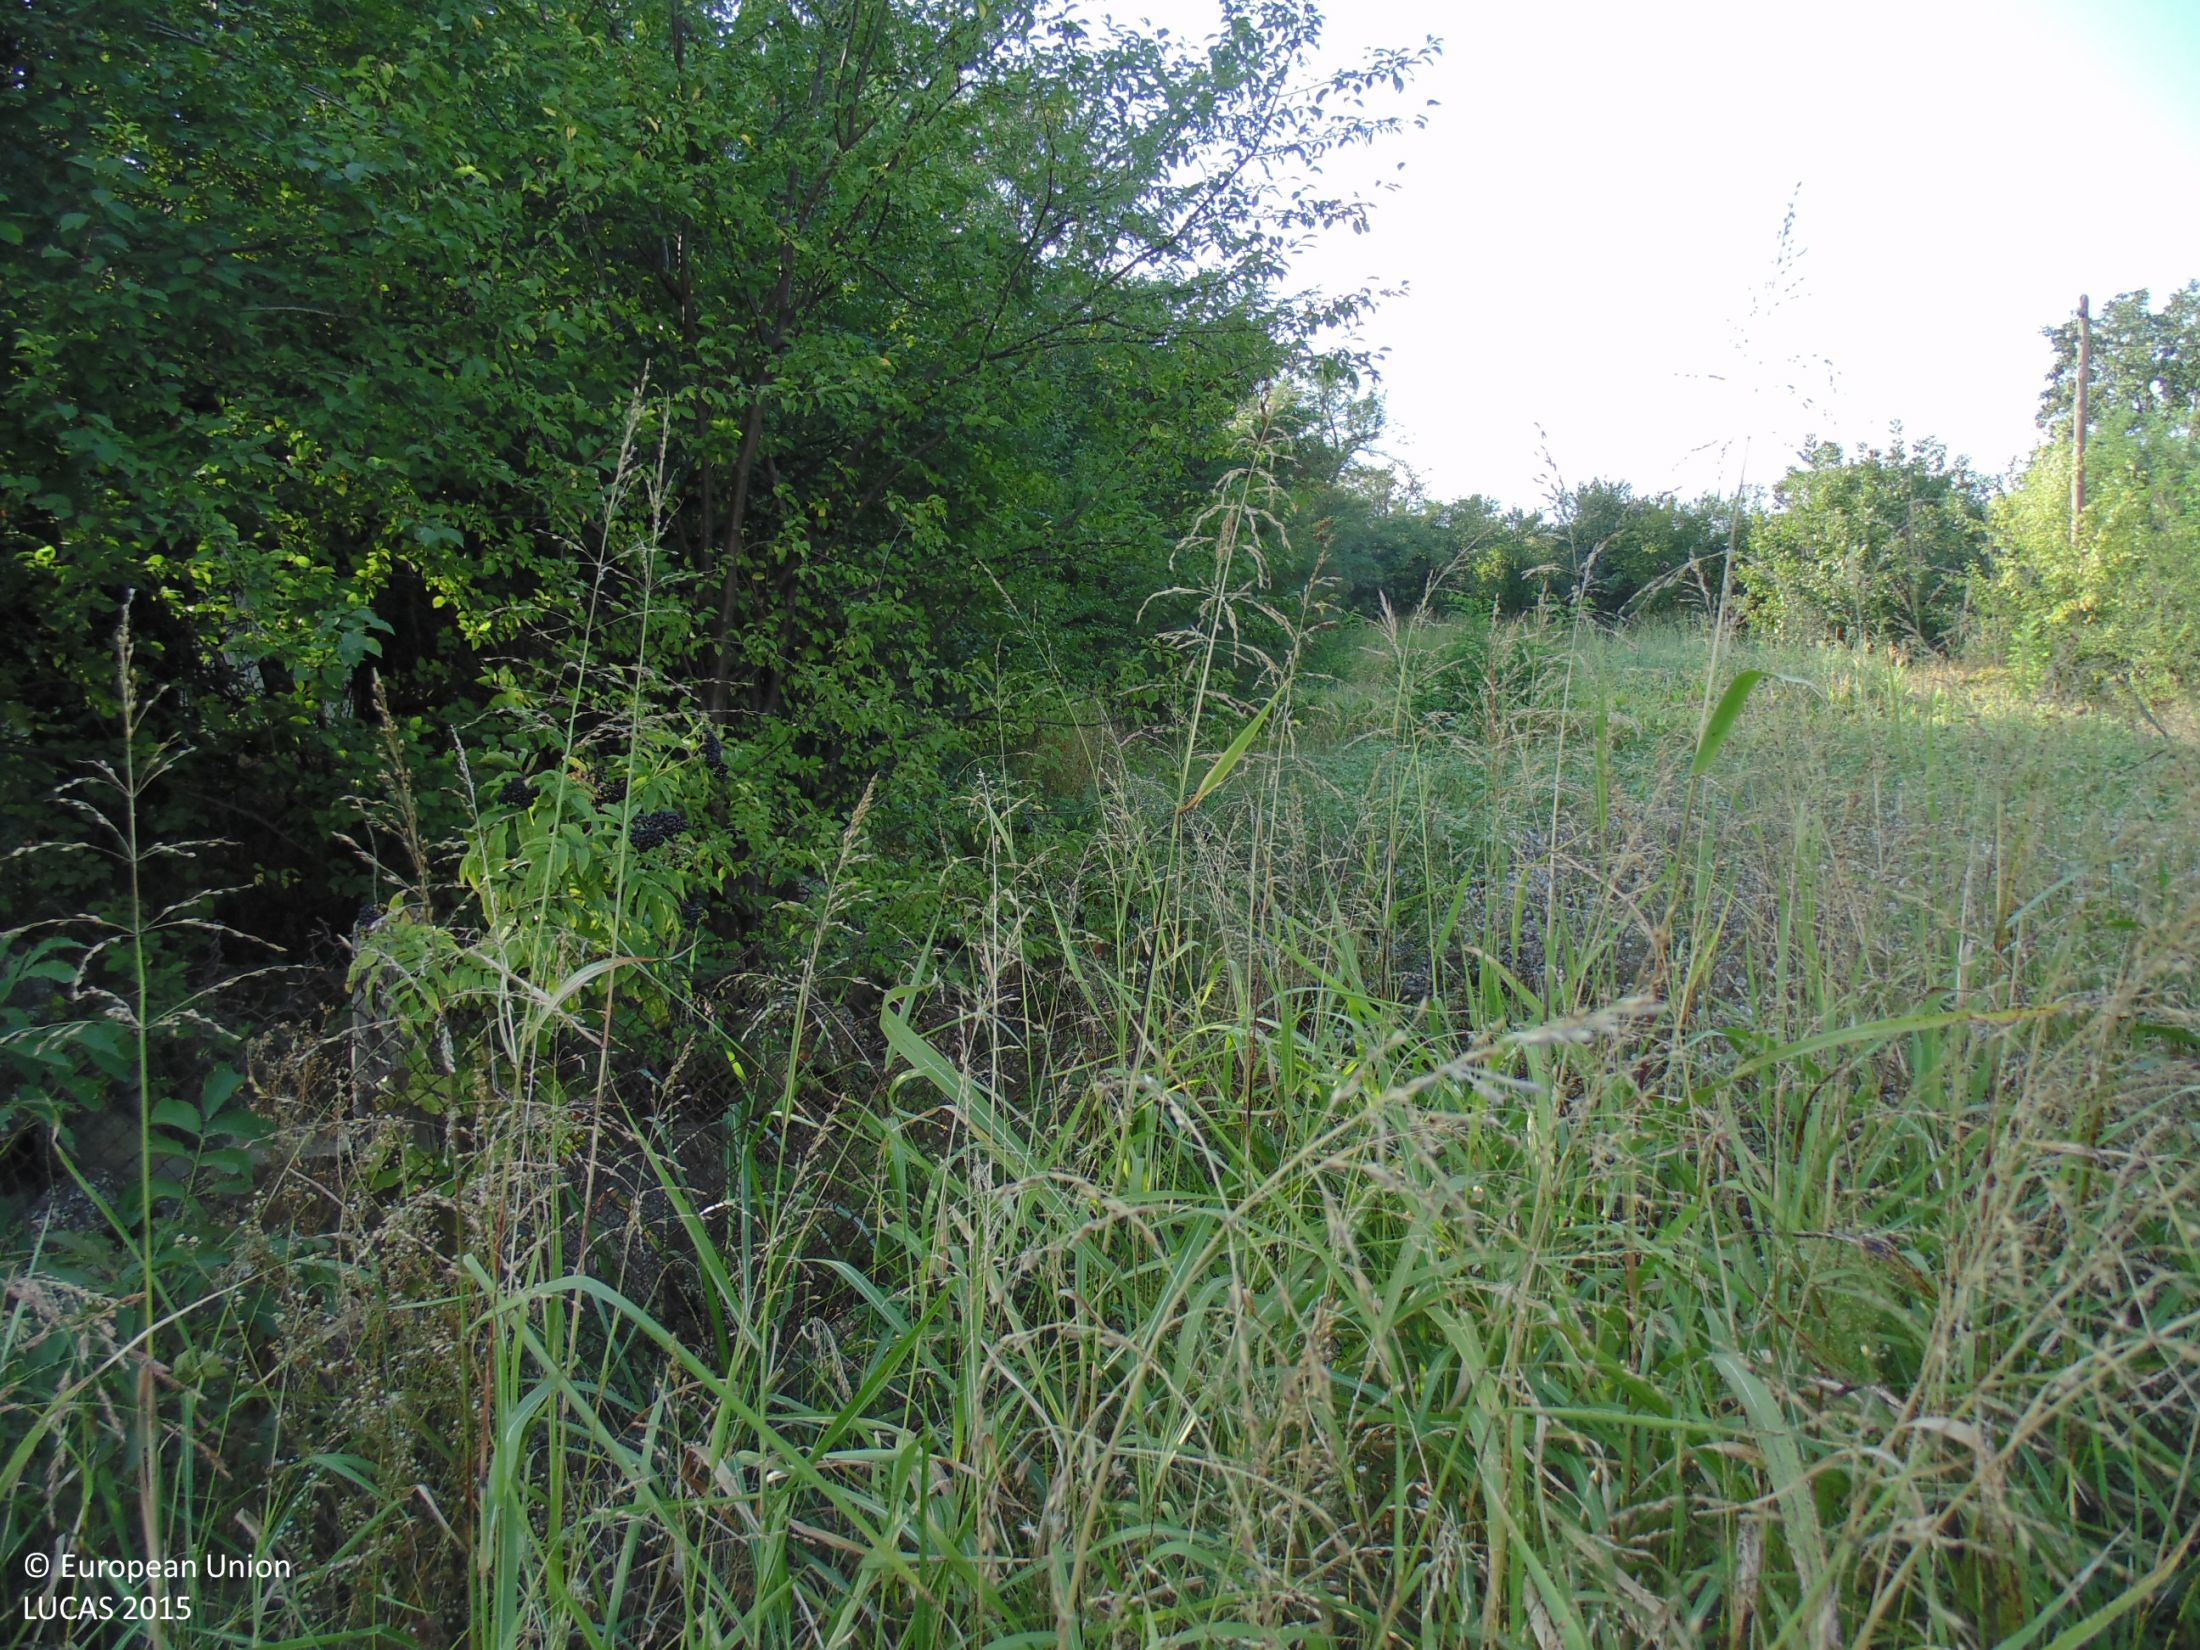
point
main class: Cropland
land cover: Other fruit trees and berries
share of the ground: 50 - 75 %
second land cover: Grassland without tree/shrub cover
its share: 50 - 75 %
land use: Kitchen garden
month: September
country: BG
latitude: 44.0485
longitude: 27.1649
